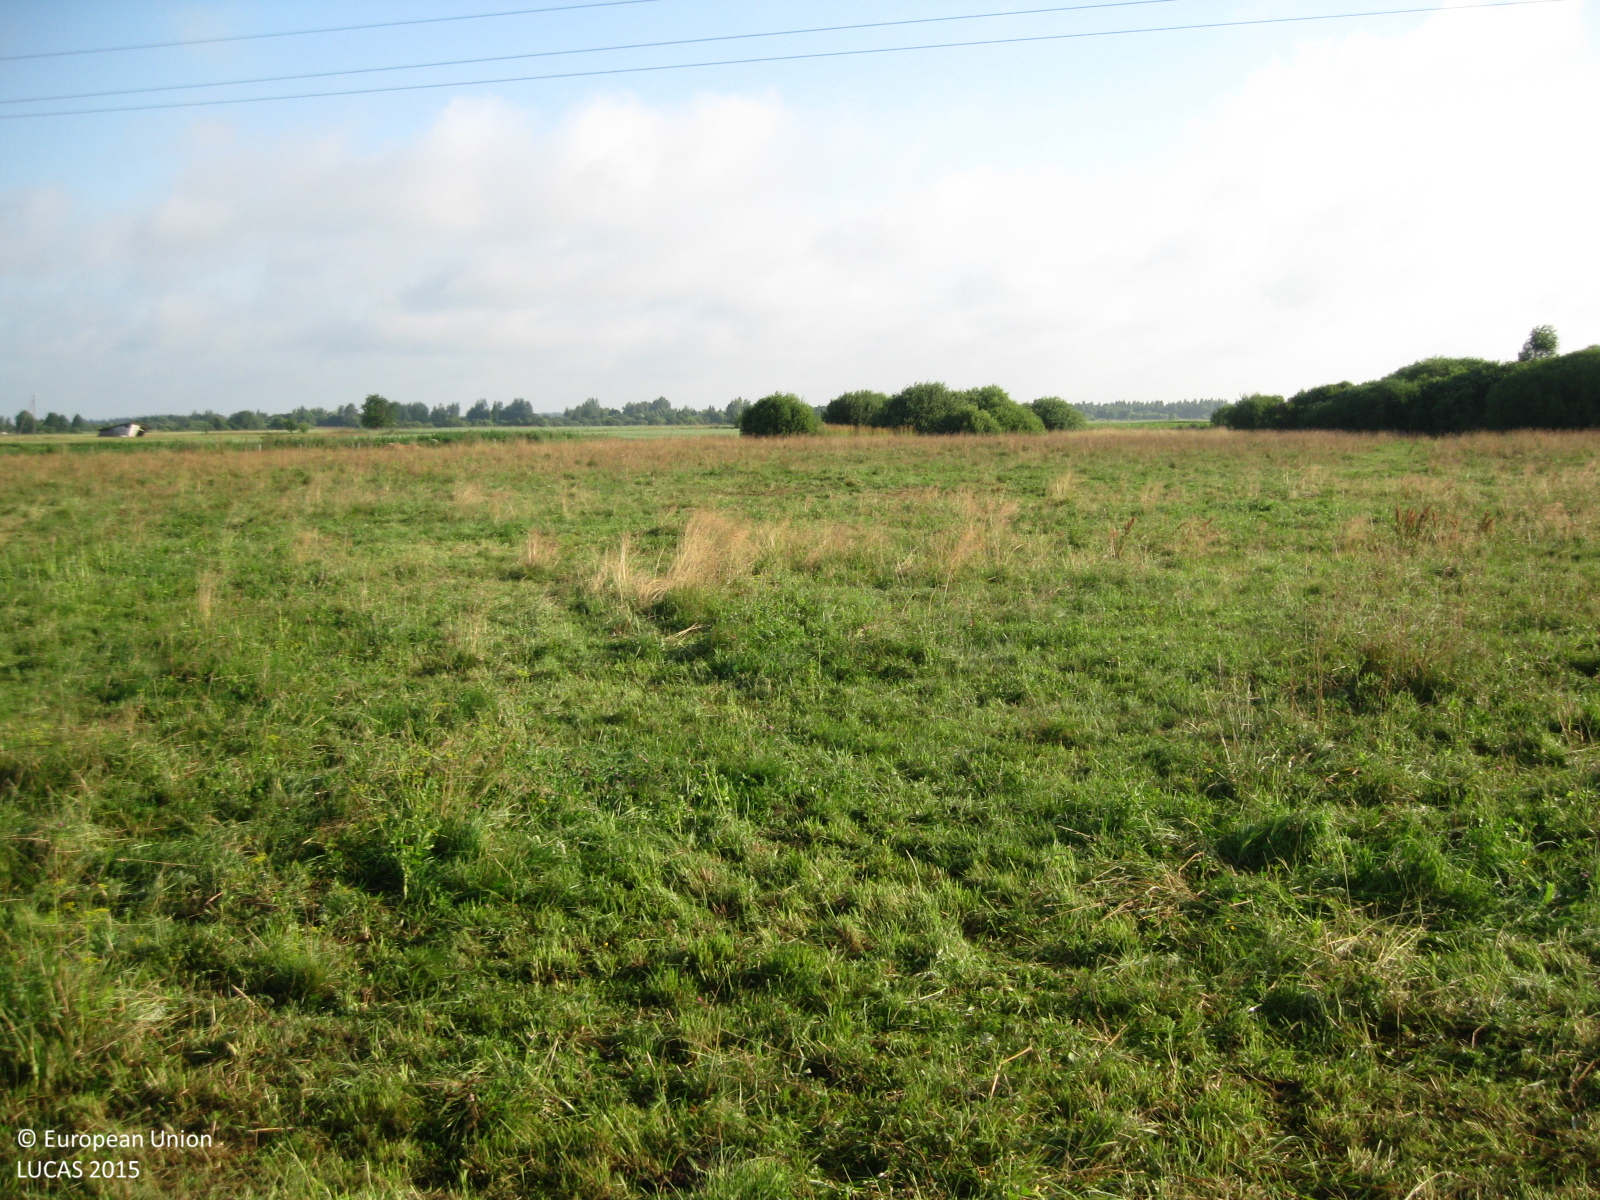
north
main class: Grassland
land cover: Grassland without tree/shrub cover
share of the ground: > 75 %
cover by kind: herbaceous plants 100 %
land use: Agriculture (excluding fallow land and kitchen gardens)
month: July
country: LT
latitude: 55.3118
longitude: 24.5819
